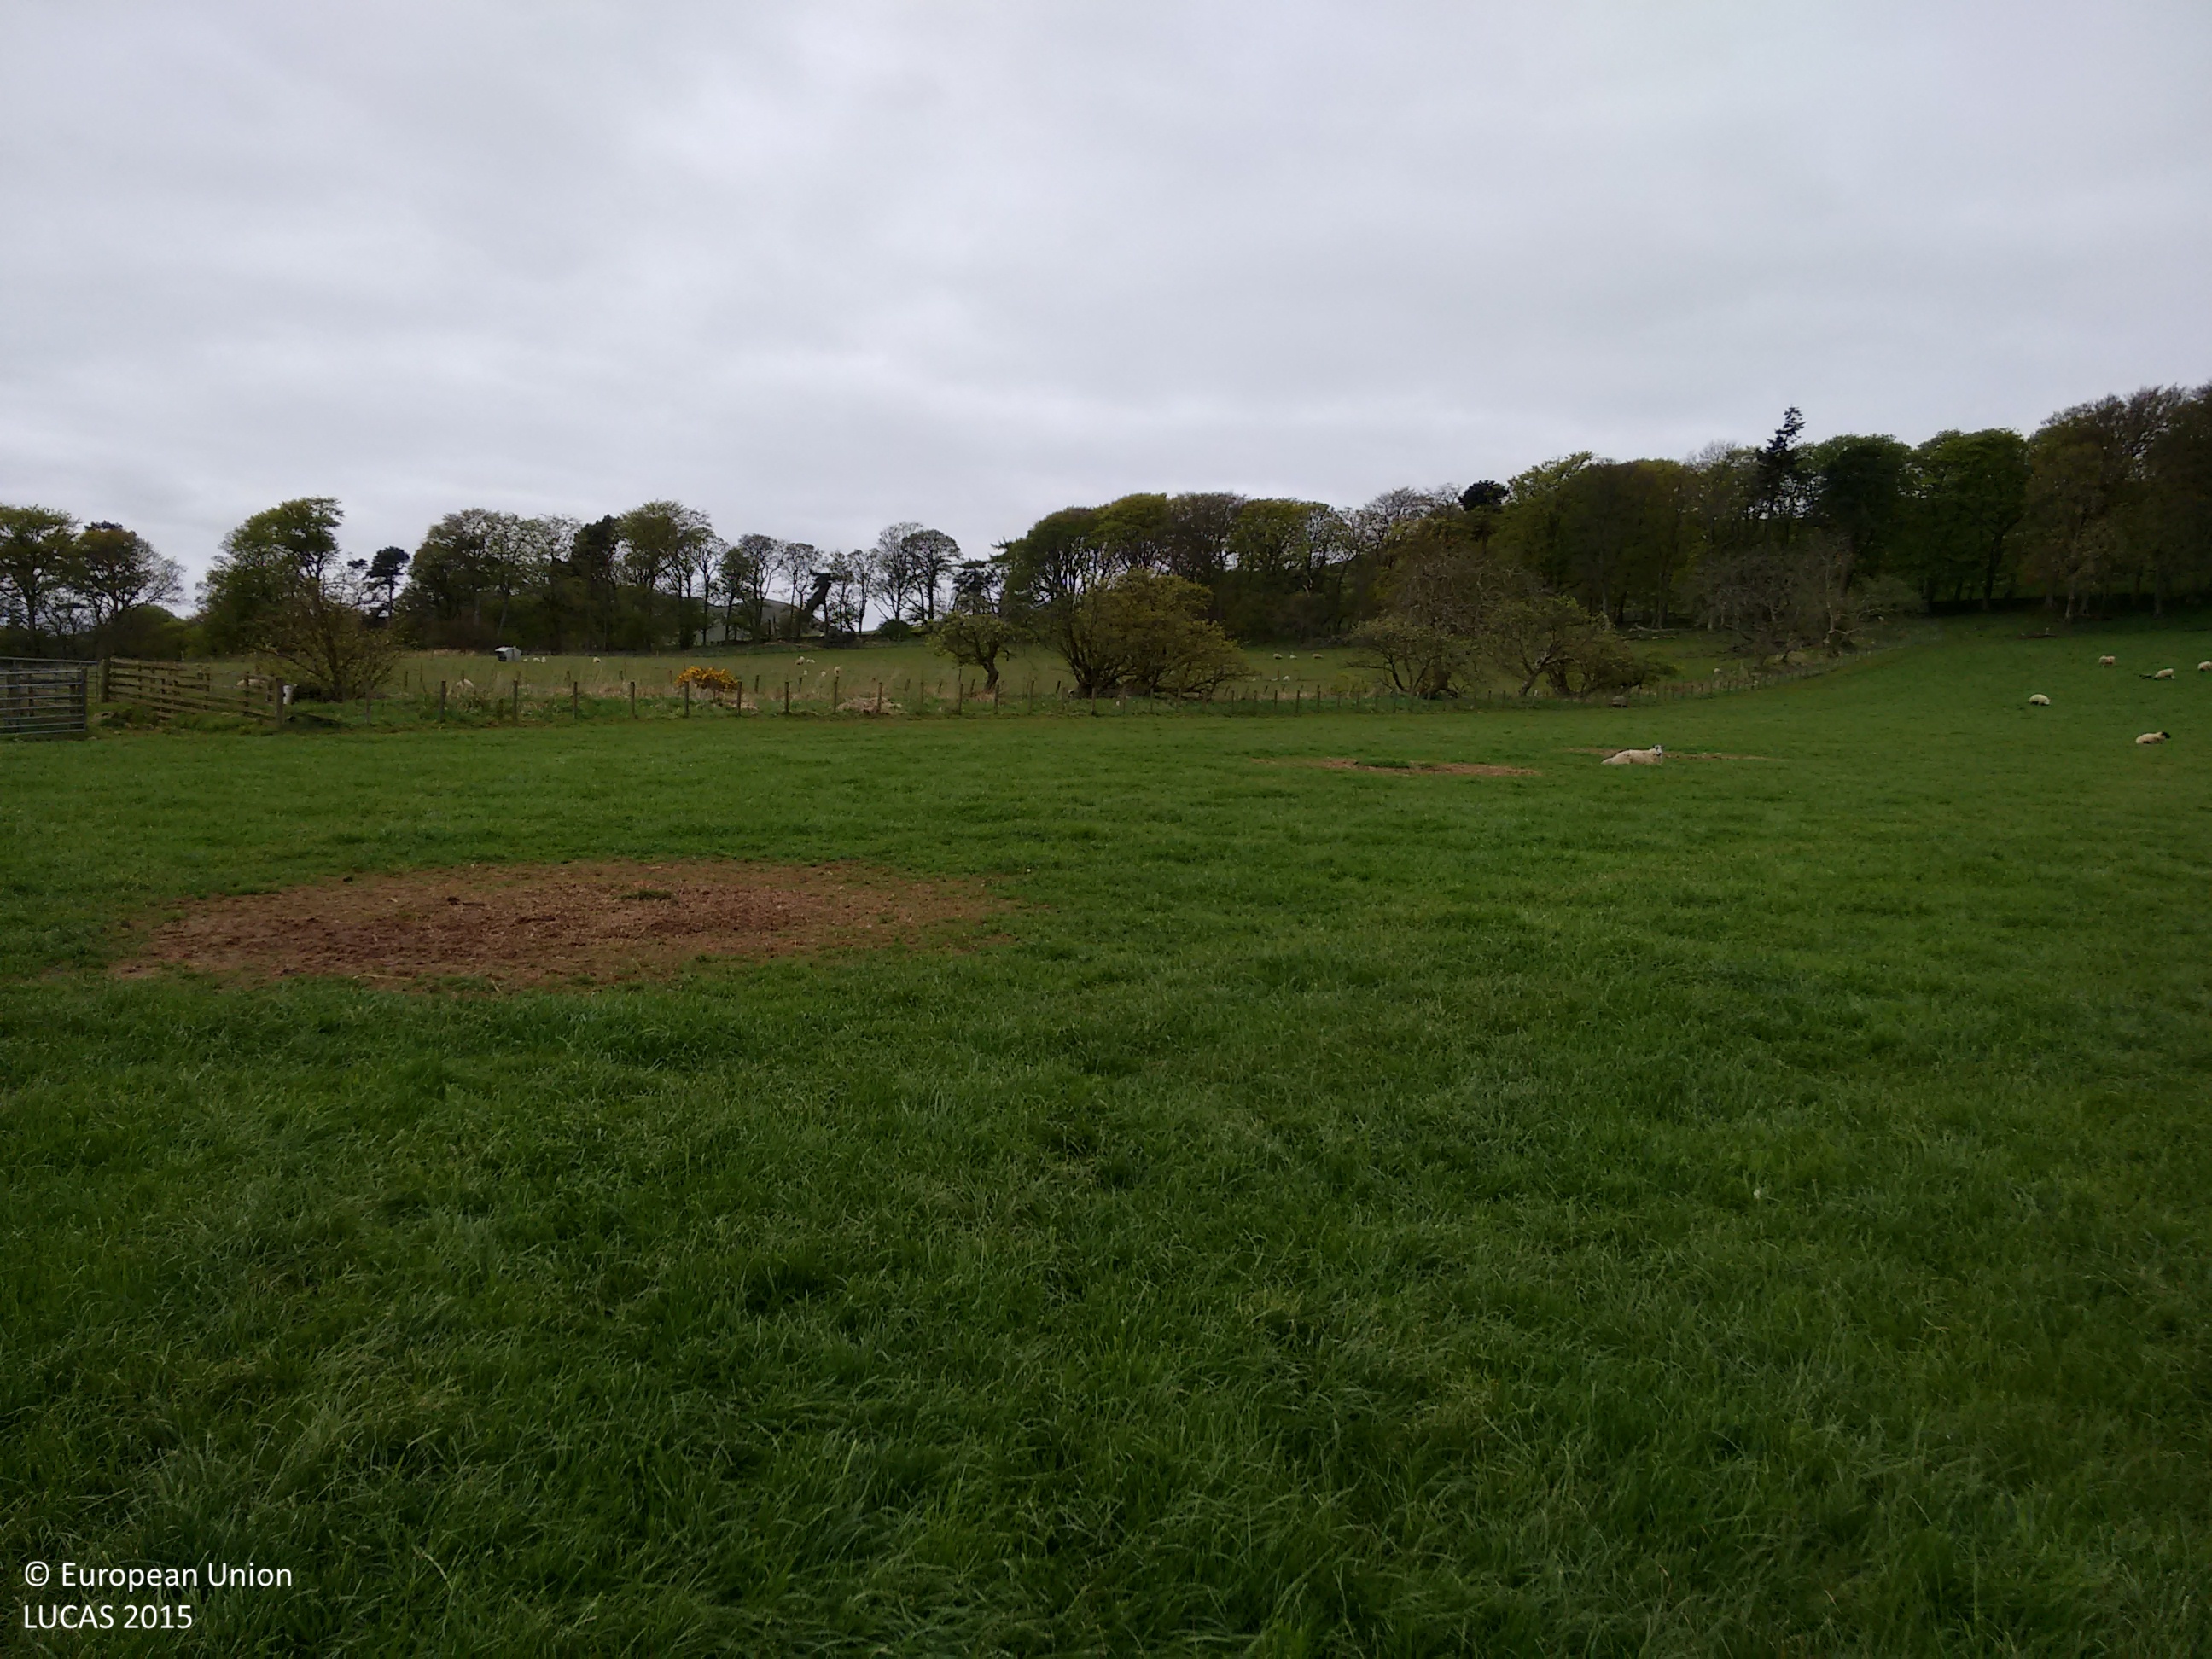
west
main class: Grassland
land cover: Grassland without tree/shrub cover
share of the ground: > 75 %
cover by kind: herbaceous plants 100 %
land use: Agriculture (excluding fallow land and kitchen gardens)
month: May
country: GB
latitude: 55.8644
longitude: -3.2230
